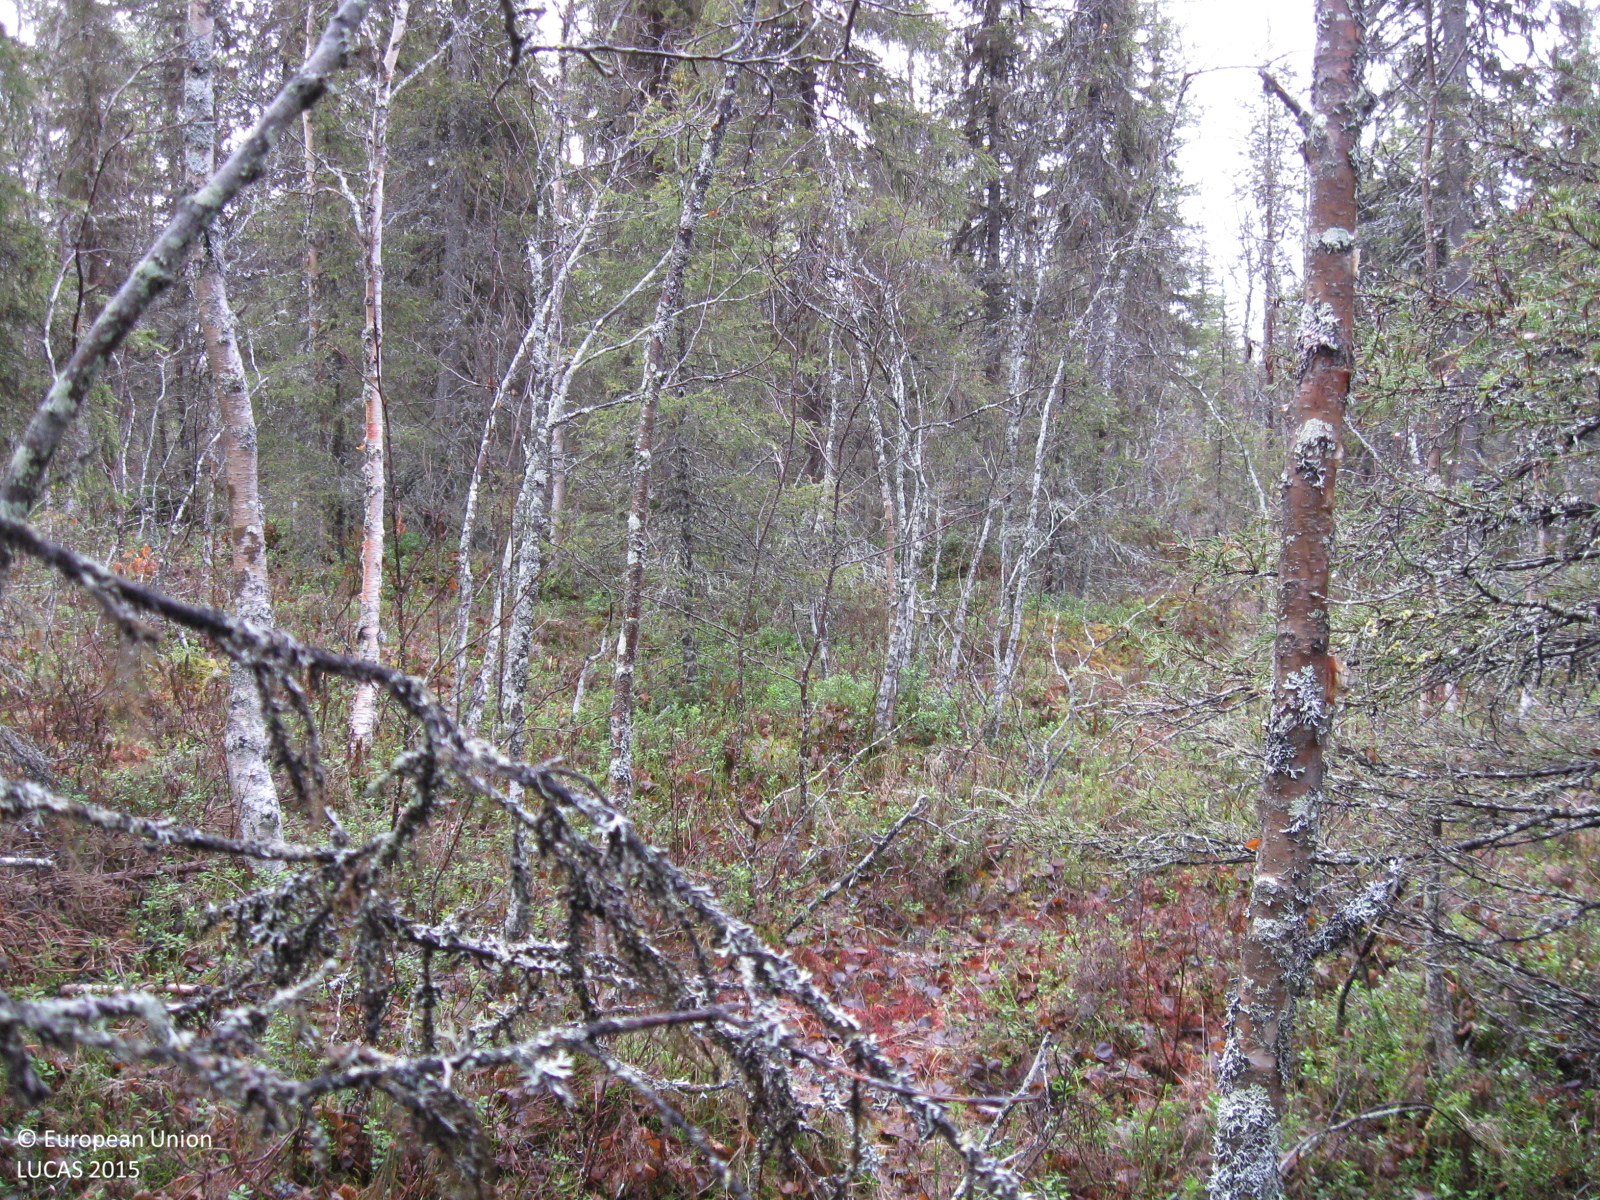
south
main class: Woodland
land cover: Spruce dominated mixed woodland
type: boreal forest
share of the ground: > 75 %
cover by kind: coniferous forest trees 50 %, broadleaved forest trees 30 %, shrubs 10 %, herbaceous plants 5 %, lichens and mosses 5 %
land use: Forestry
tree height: > 5 m
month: October
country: SE
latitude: 66.7548
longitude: 21.0596
